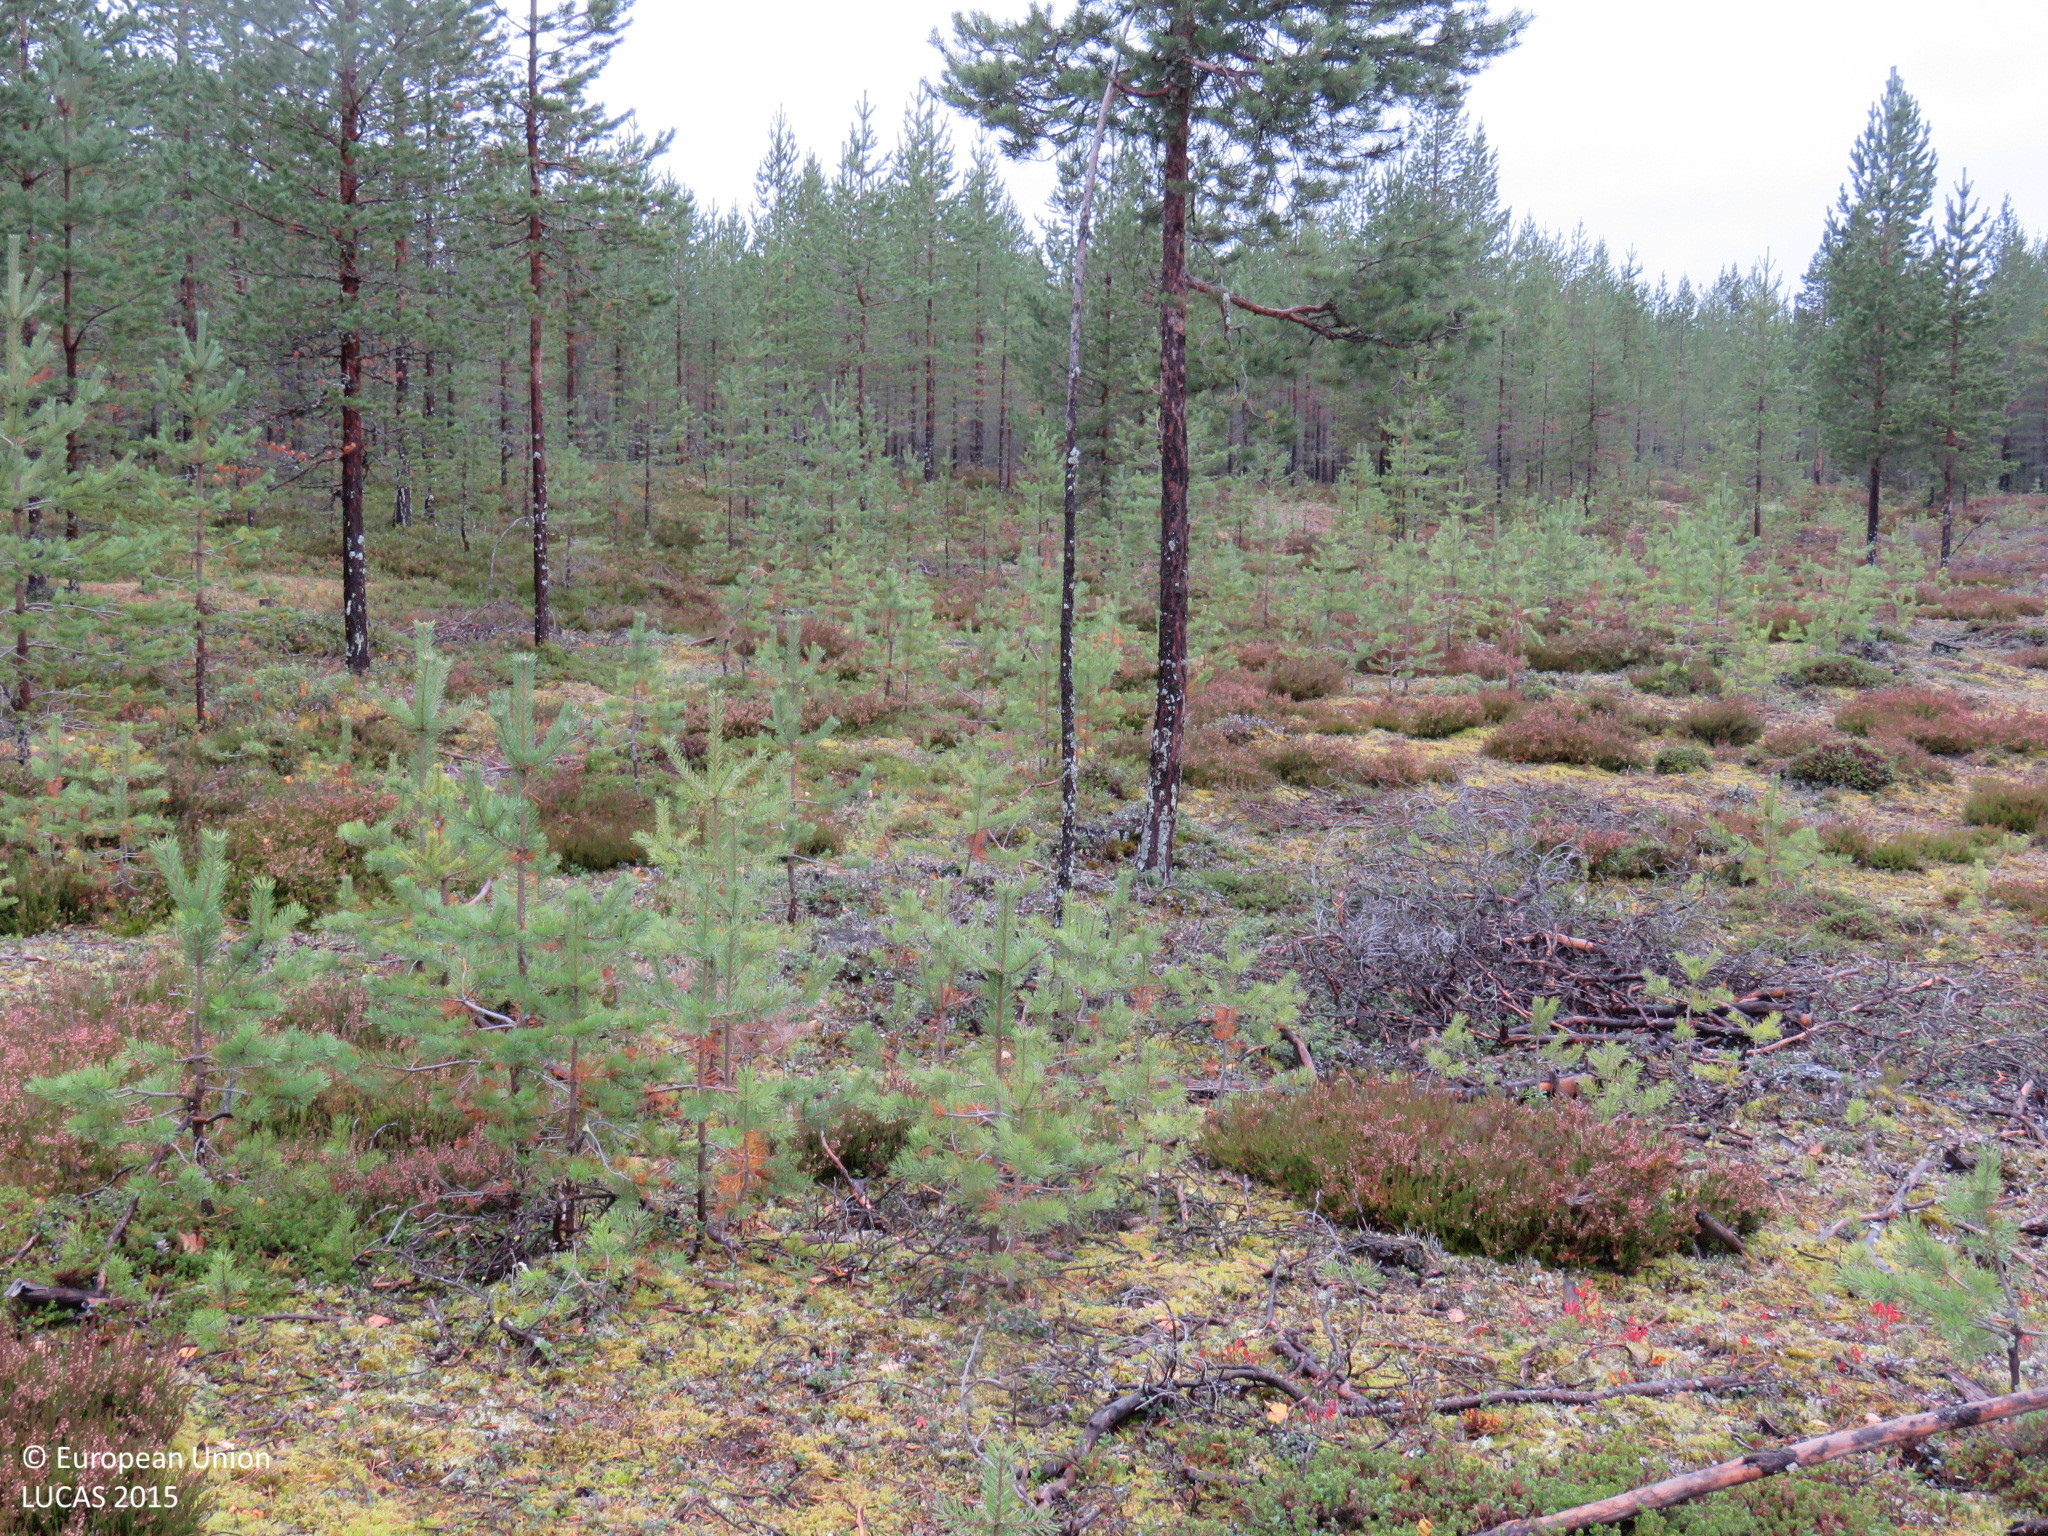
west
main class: Woodland
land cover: Pine dominated coniferous woodland
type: boreal forest
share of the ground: 25 - 50 %
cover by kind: shrubs 45 %, lichens and mosses 30 %, coniferous forest trees 25 %
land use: Forestry
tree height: < 5 m
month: September
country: FI
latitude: 65.2007
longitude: 26.6255
